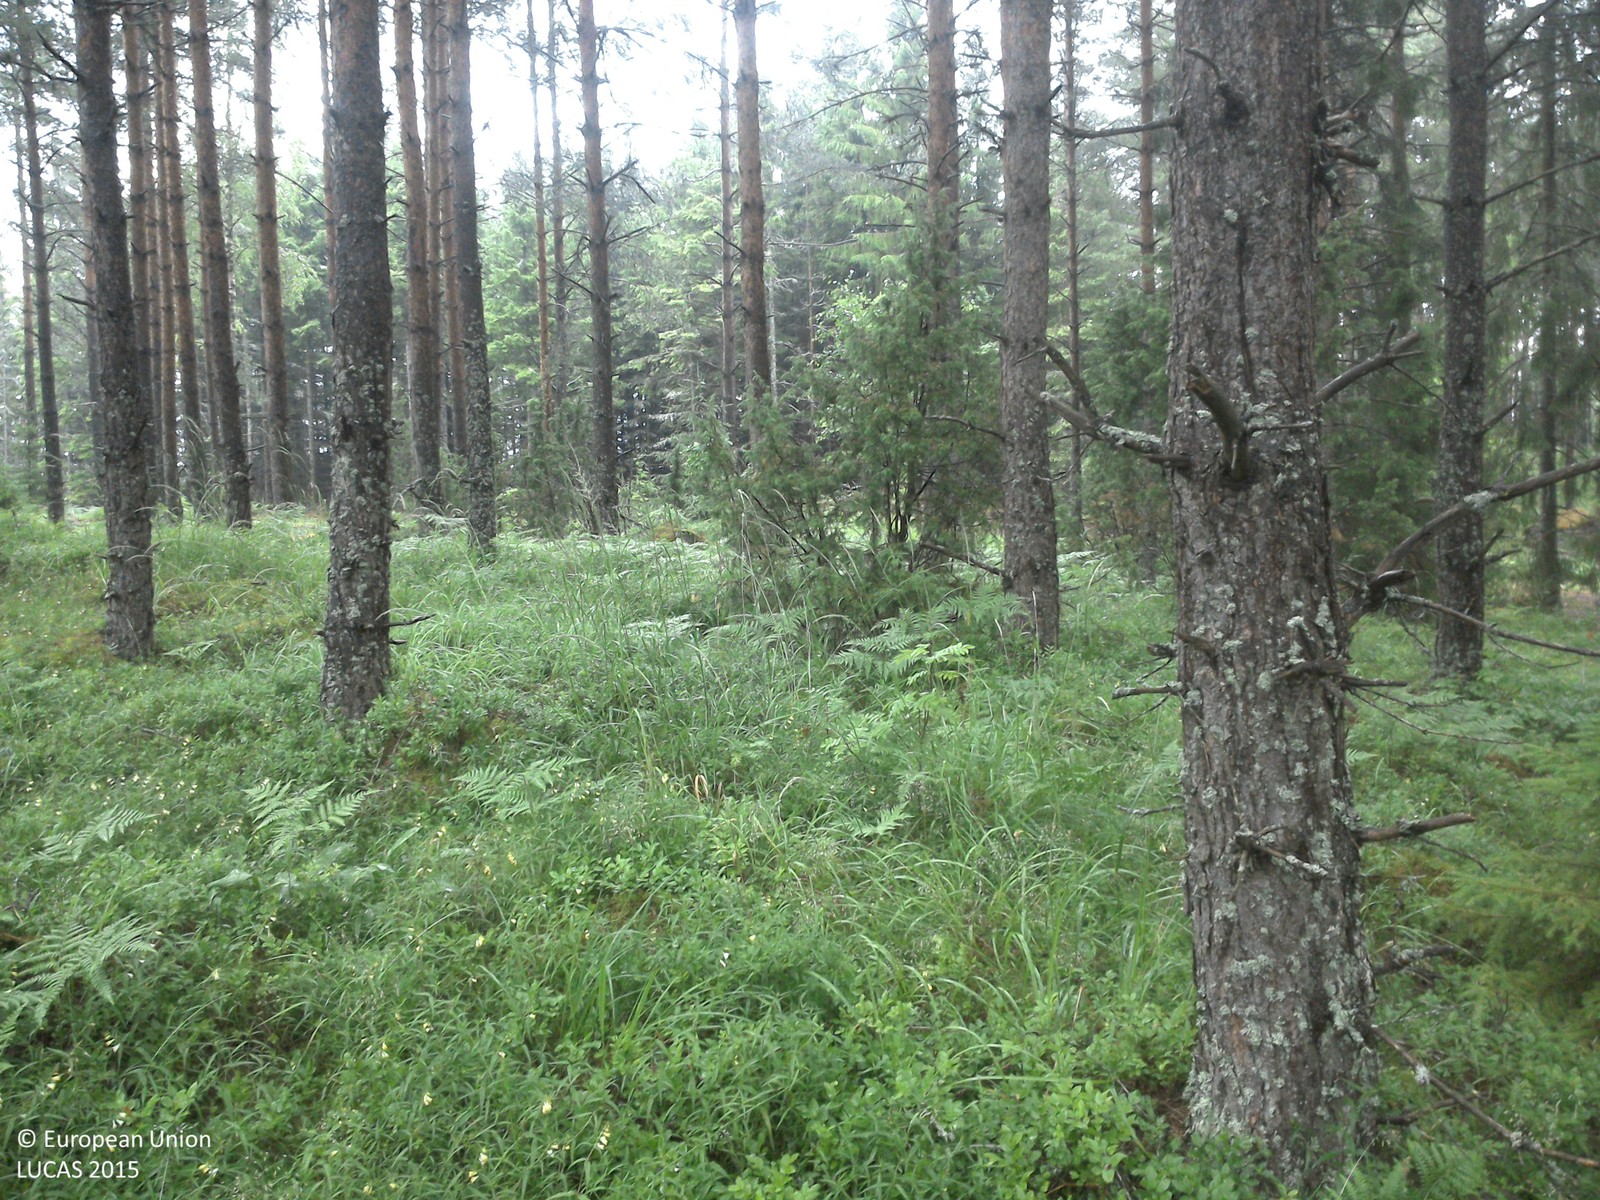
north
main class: Woodland
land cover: Pine dominated coniferous woodland
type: boreal forest
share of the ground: > 75 %
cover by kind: coniferous forest trees 75 %, herbaceous plants 25 %
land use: Forestry
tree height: > 5 m
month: July
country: SE
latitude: 58.6093
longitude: 15.1057
